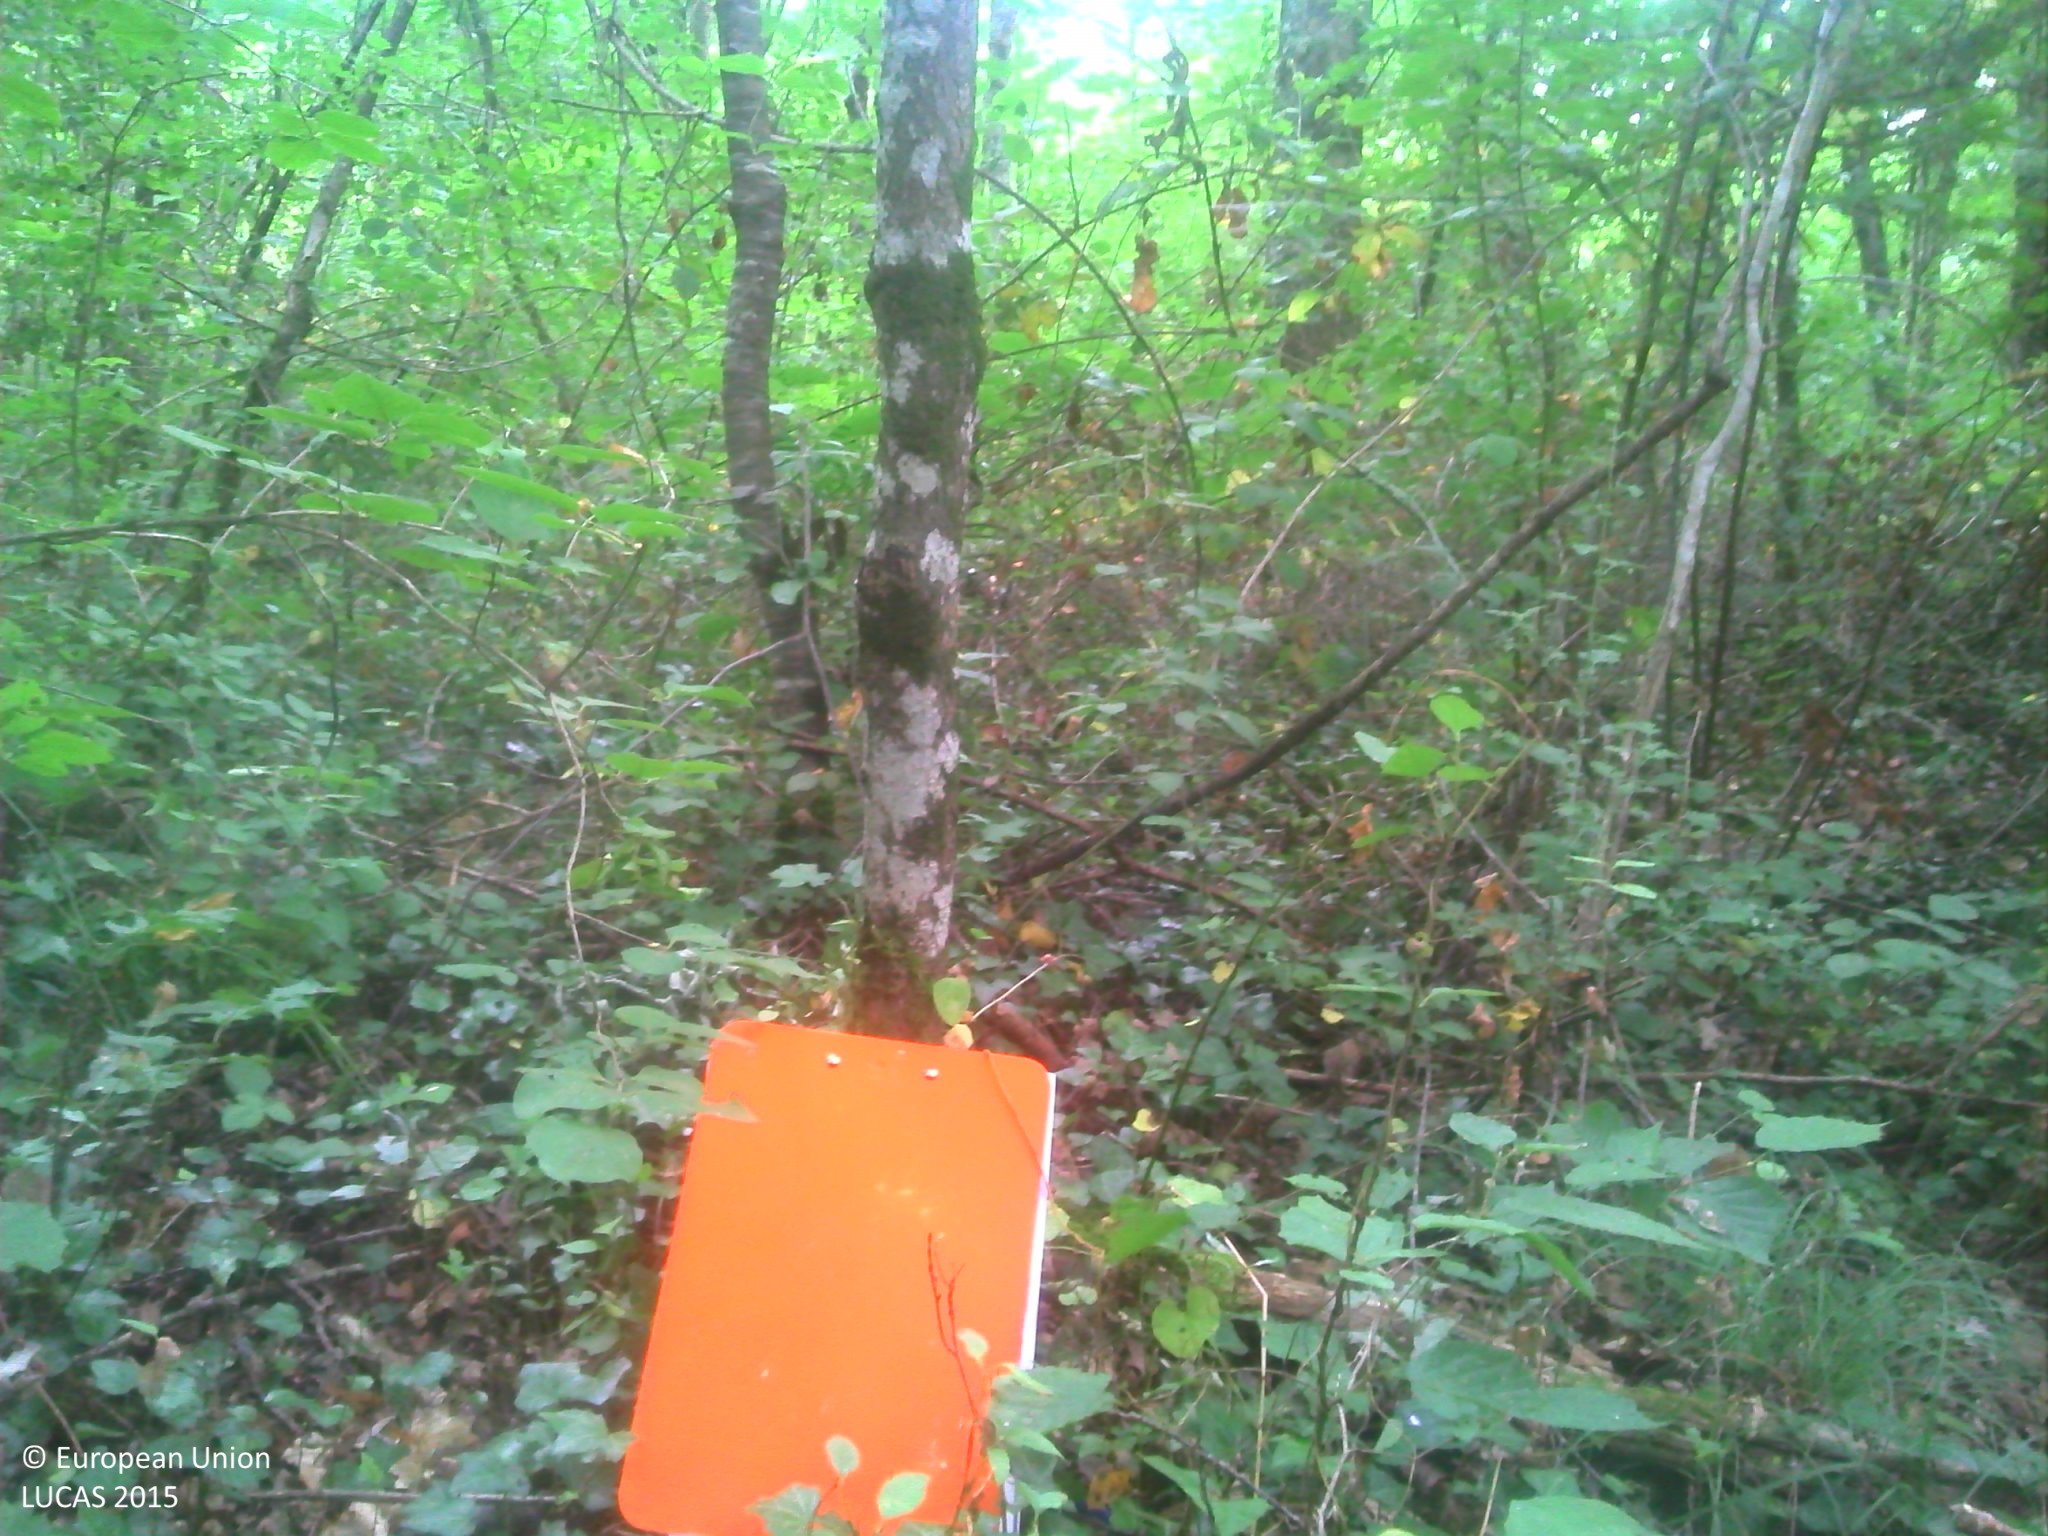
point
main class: Woodland
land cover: Broadleaved woodland
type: acidophilous oak and oak-birch forest
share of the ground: > 75 %
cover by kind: broadleaved forest trees 60 %, shrubs 30 %, herbaceous plants 10 %
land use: Forestry
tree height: > 5 m
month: July
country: FR
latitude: 43.2910
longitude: 1.4632
